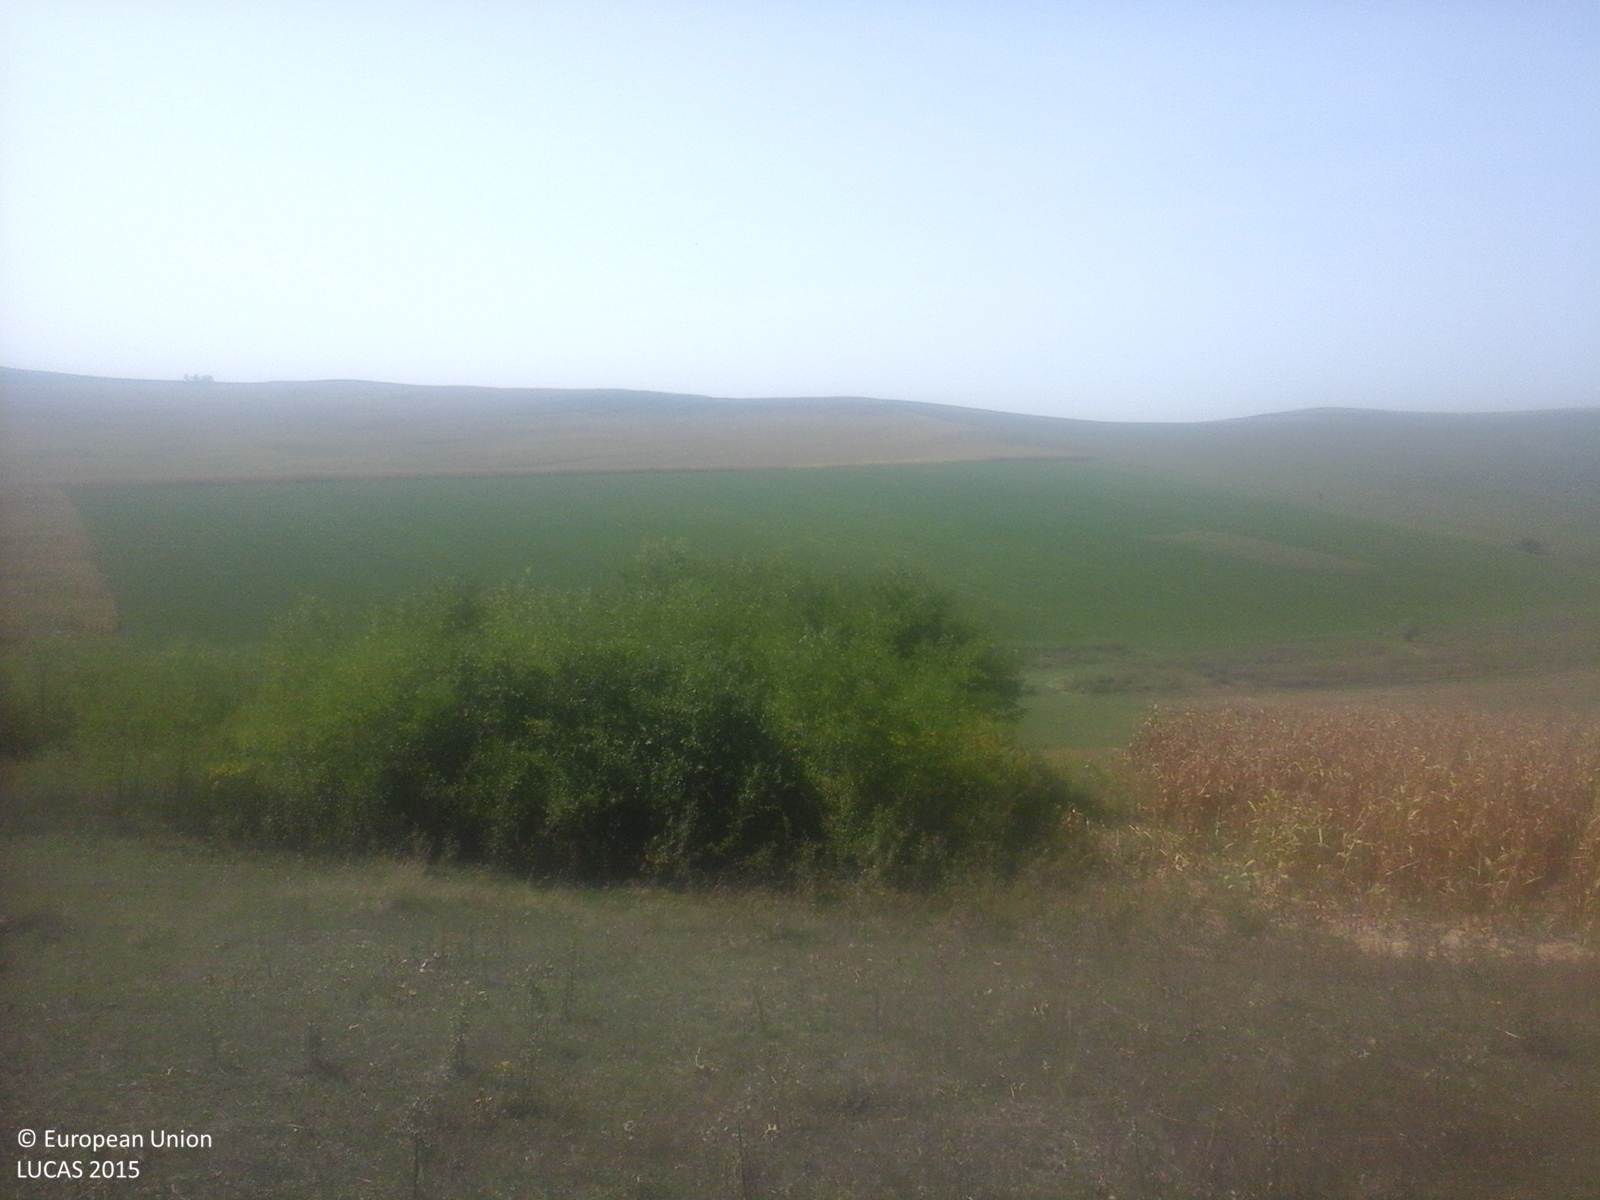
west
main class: Grassland
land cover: Spontaneously vegetated surfaces
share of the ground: > 75 %
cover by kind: herbaceous plants 100 %
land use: Agriculture (excluding fallow land and kitchen gardens)
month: September
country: RO
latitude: 46.8835
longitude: 24.2971
